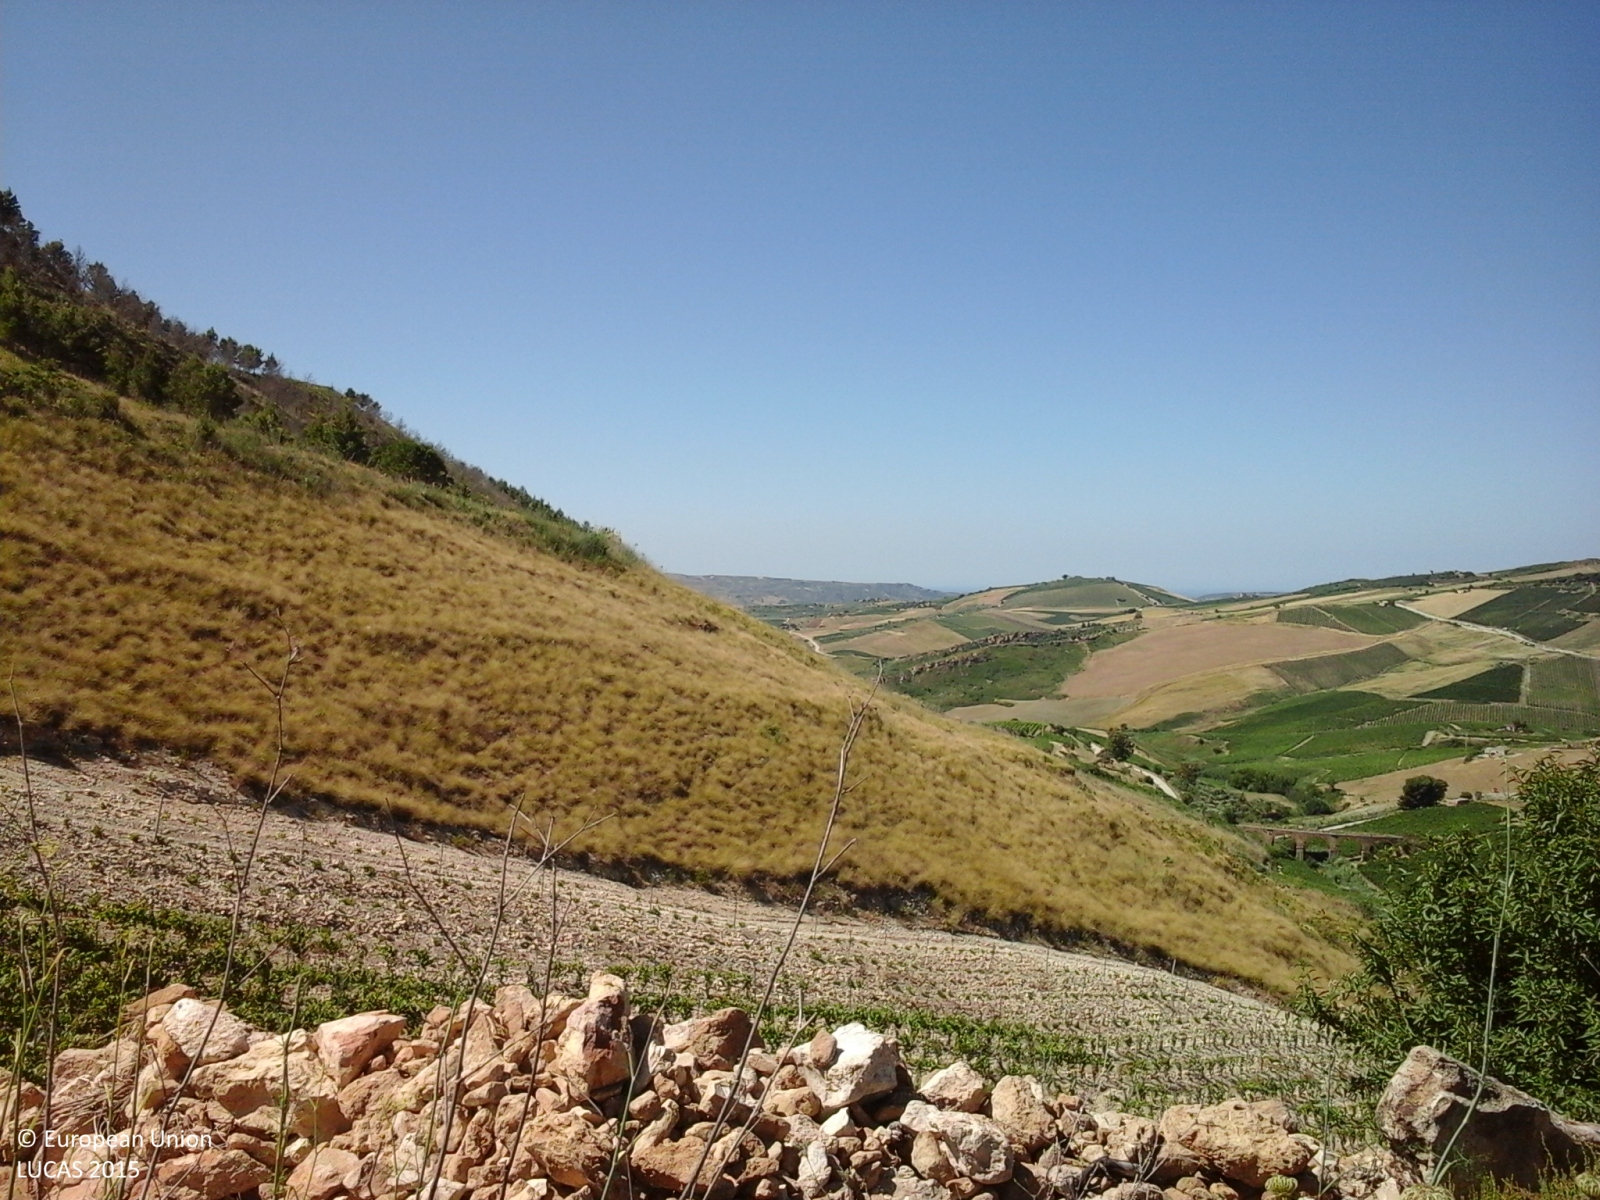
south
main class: Grassland
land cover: Grassland without tree/shrub cover
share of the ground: > 75 %
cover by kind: herbaceous plants 90 %, unconsolidated bare surface 10 %
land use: Agriculture (excluding fallow land and kitchen gardens)
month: June
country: IT
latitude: 37.7915
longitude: 12.9872
